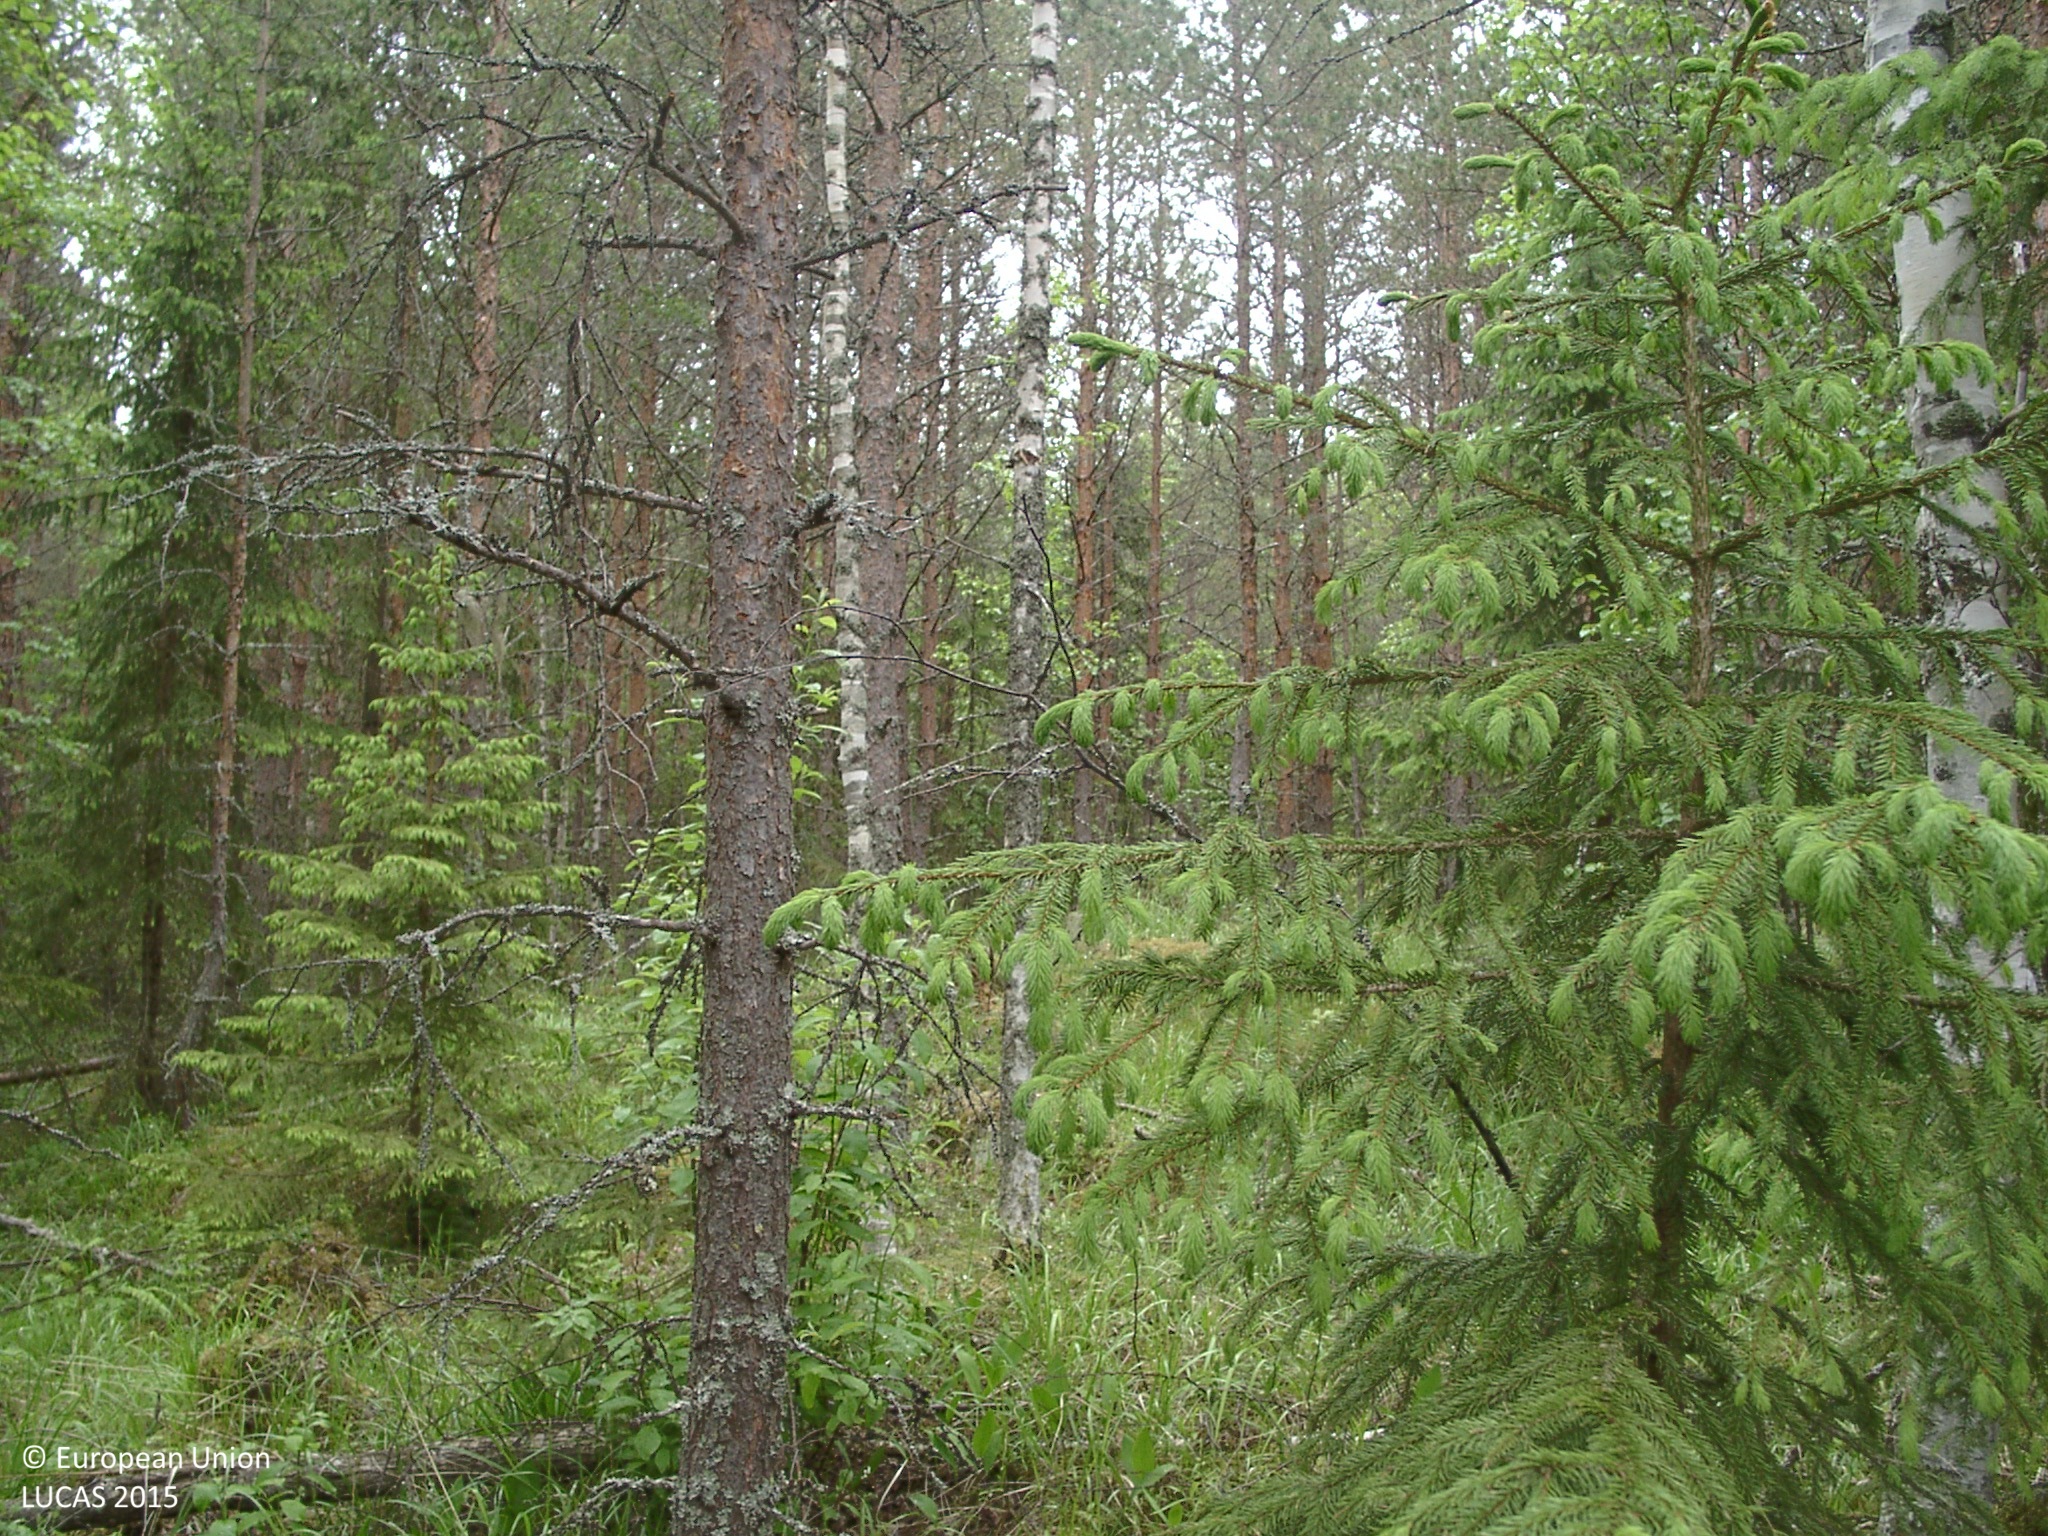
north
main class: Woodland
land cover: Spruce dominated mixed woodland
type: boreal forest
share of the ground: 50 - 75 %
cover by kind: coniferous forest trees 40 %, broadleaved forest trees 25 %, shrubs 20 %, herbaceous plants 10 %, lichens and mosses 5 %
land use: Semi-natural and natural areas not in use
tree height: > 5 m
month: June
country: FI
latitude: 61.6819
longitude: 24.7089
